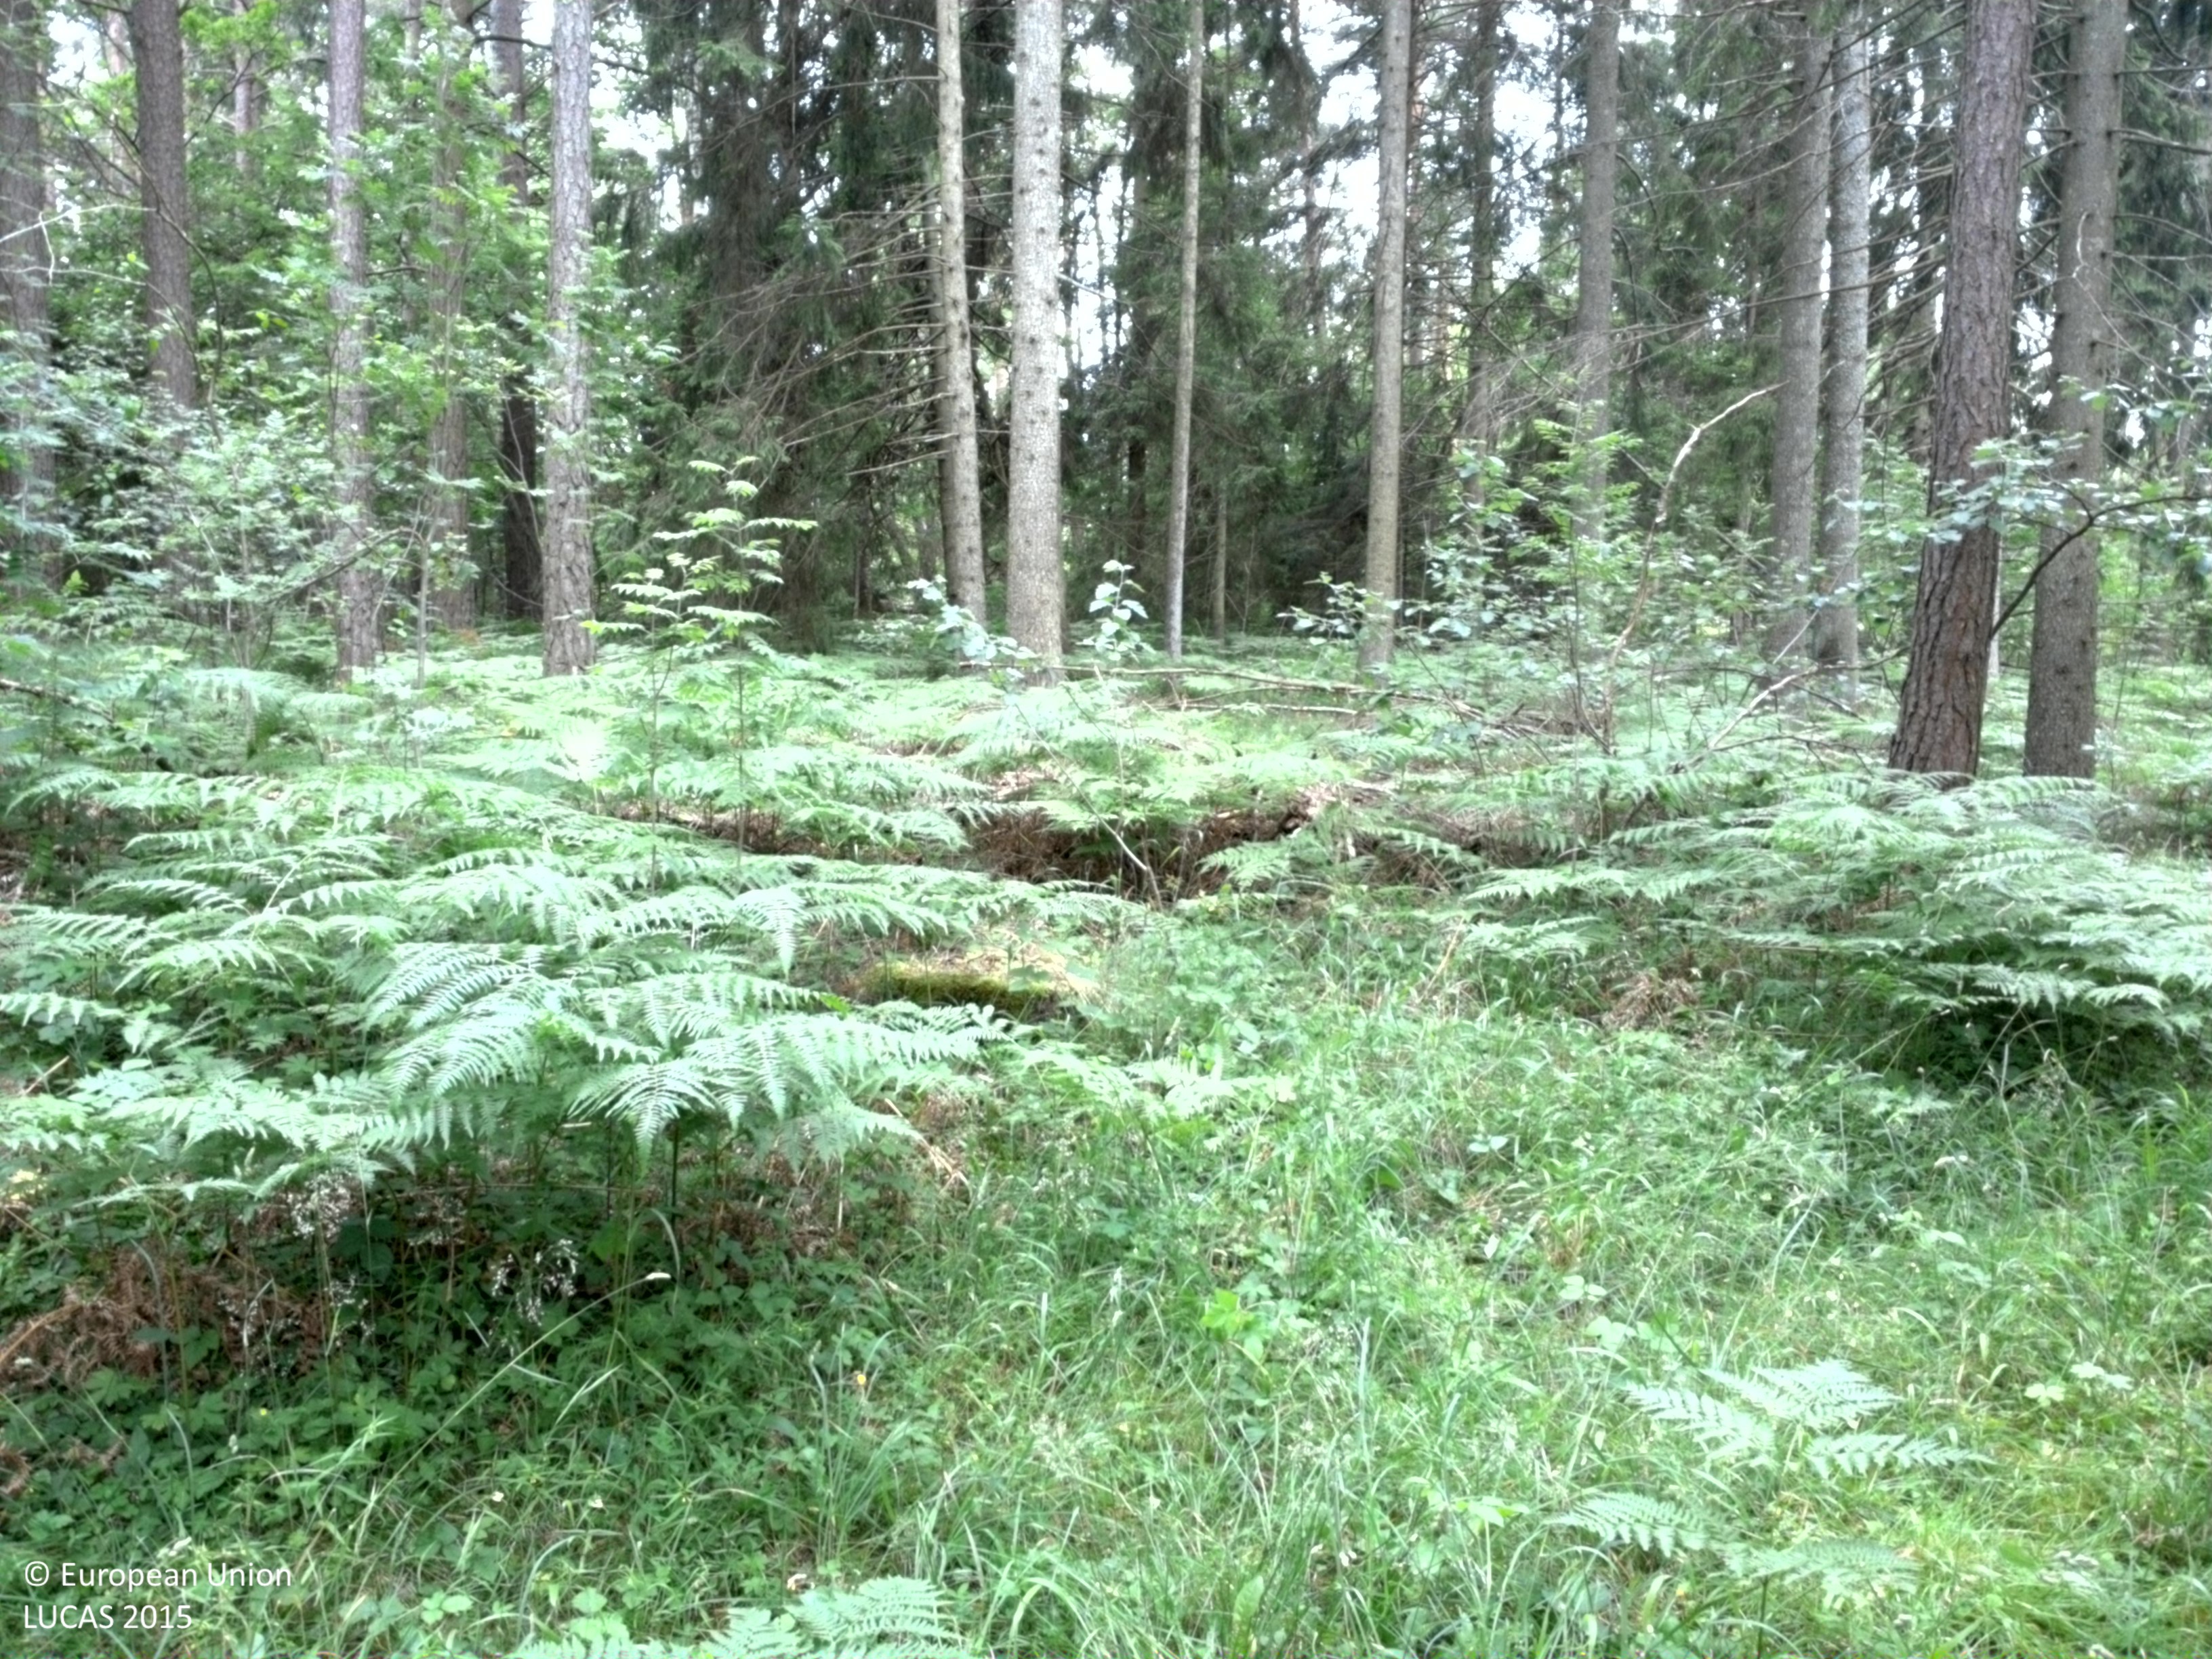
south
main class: Woodland
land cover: Spruce dominated coniferous woodland
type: hemiboreal forest and nemoral coniferous forest and mixed broadleaved-coniferous forest
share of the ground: 50 - 75 %
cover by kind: coniferous forest trees 60 %, herbaceous plants 25 %, shrubs 10 %, broadleaved forest trees 5 %
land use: Forestry
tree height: > 5 m
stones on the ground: < 10 %
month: July
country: SE
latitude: 57.4796
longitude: 18.4978
